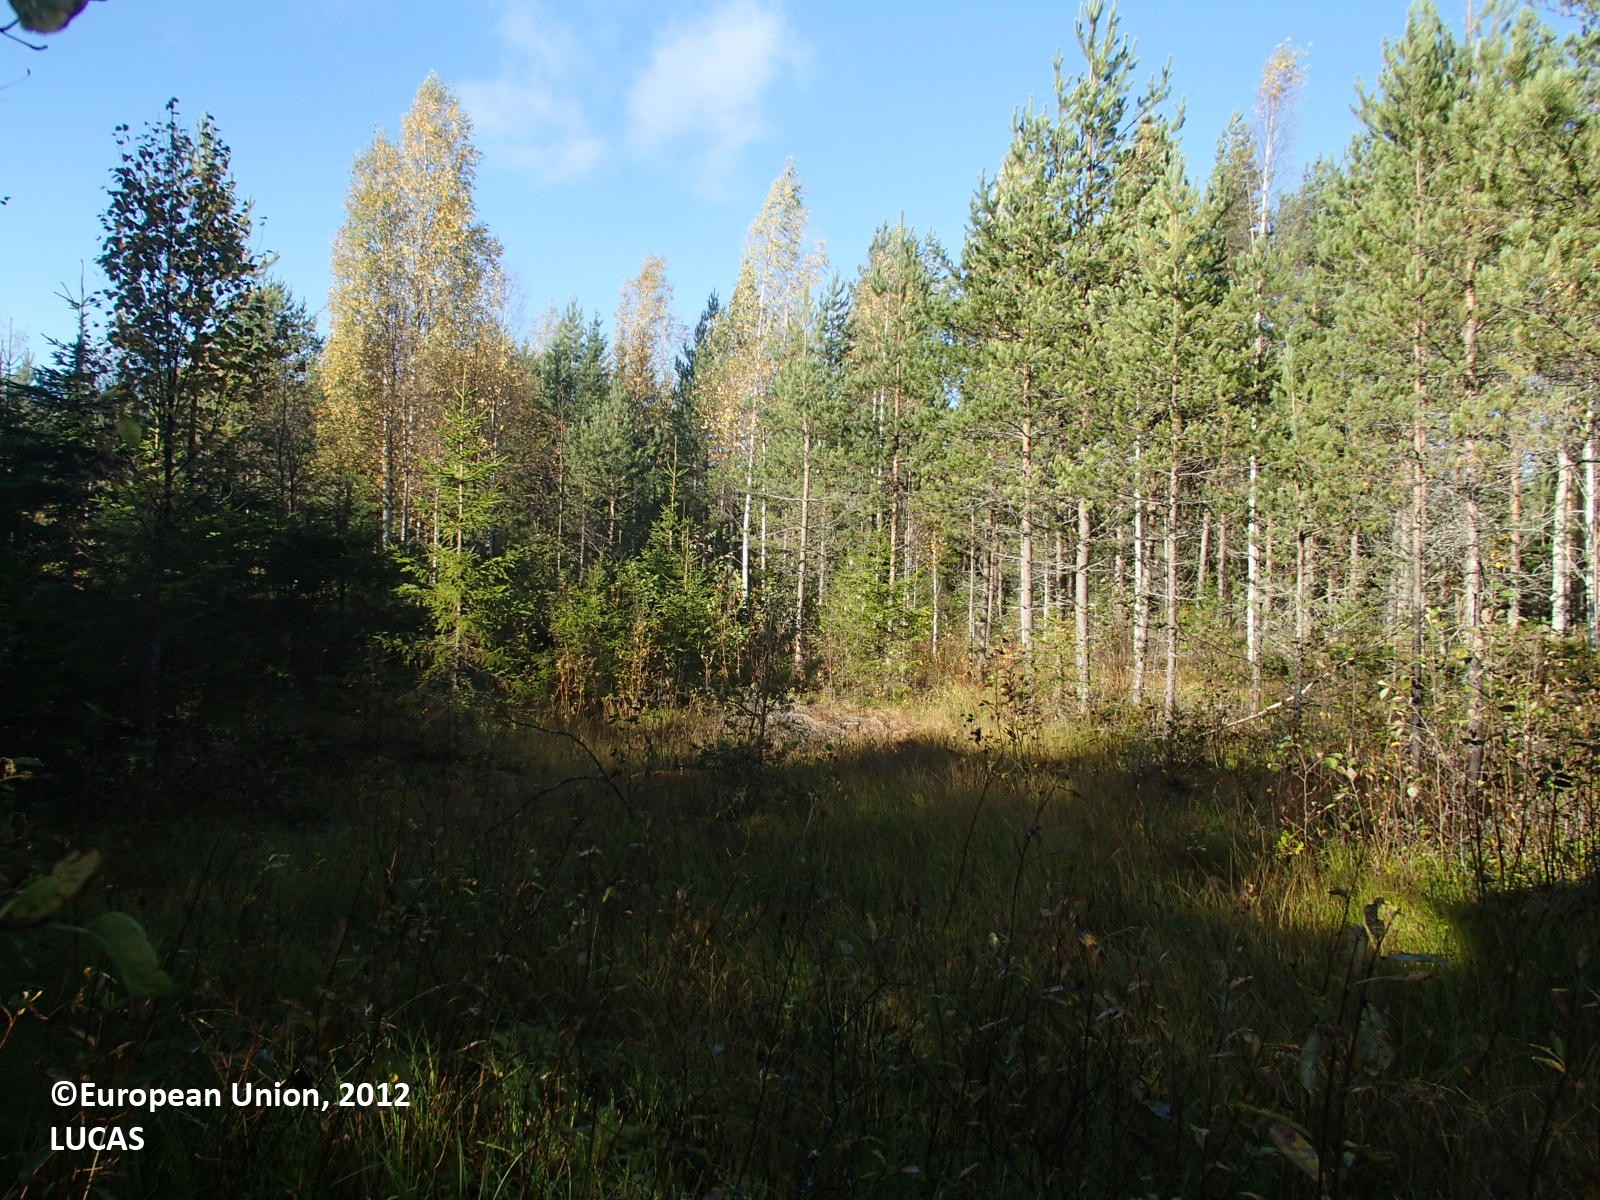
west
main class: Woodland
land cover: Pine dominated mixed woodland
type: boreal forest
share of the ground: 25 - 50 %
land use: Forestry
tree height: > 5 m
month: September
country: FI
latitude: 63.4246
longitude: 26.9083
